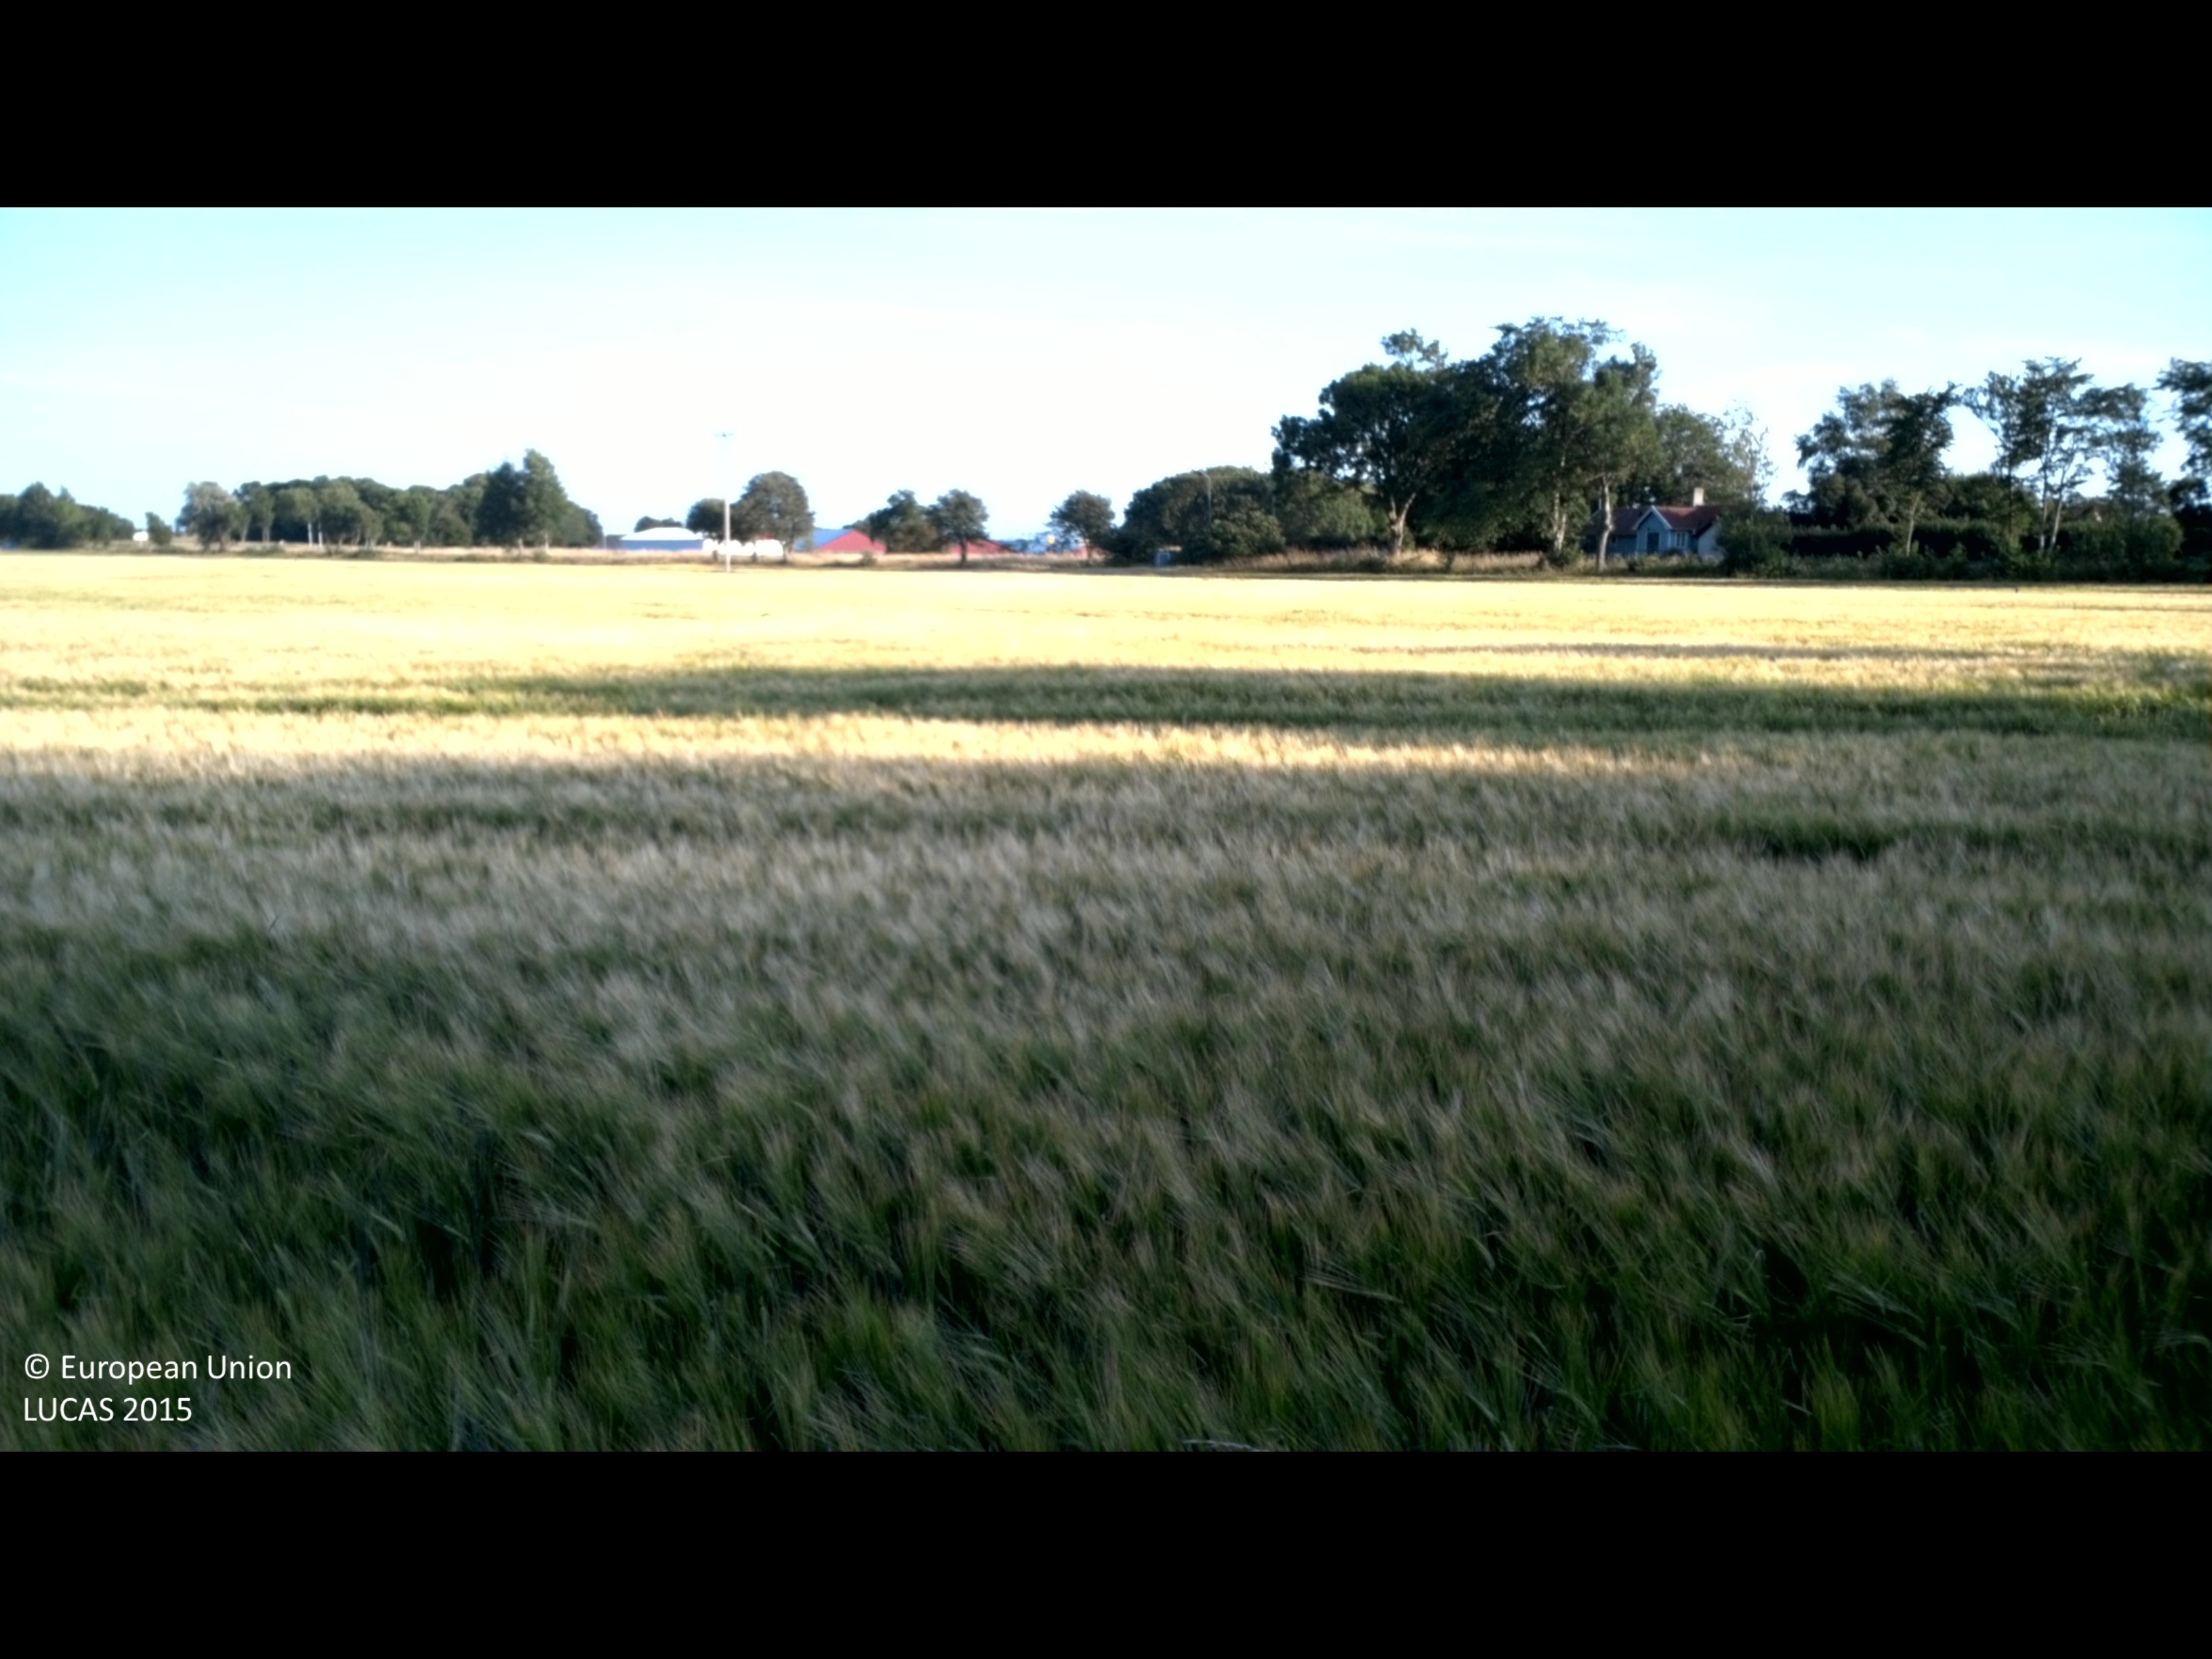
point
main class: Cropland
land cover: Barley
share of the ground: > 75 %
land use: Agriculture (excluding fallow land and kitchen gardens)
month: July
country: SE
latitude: 56.2620
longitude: 16.4113
